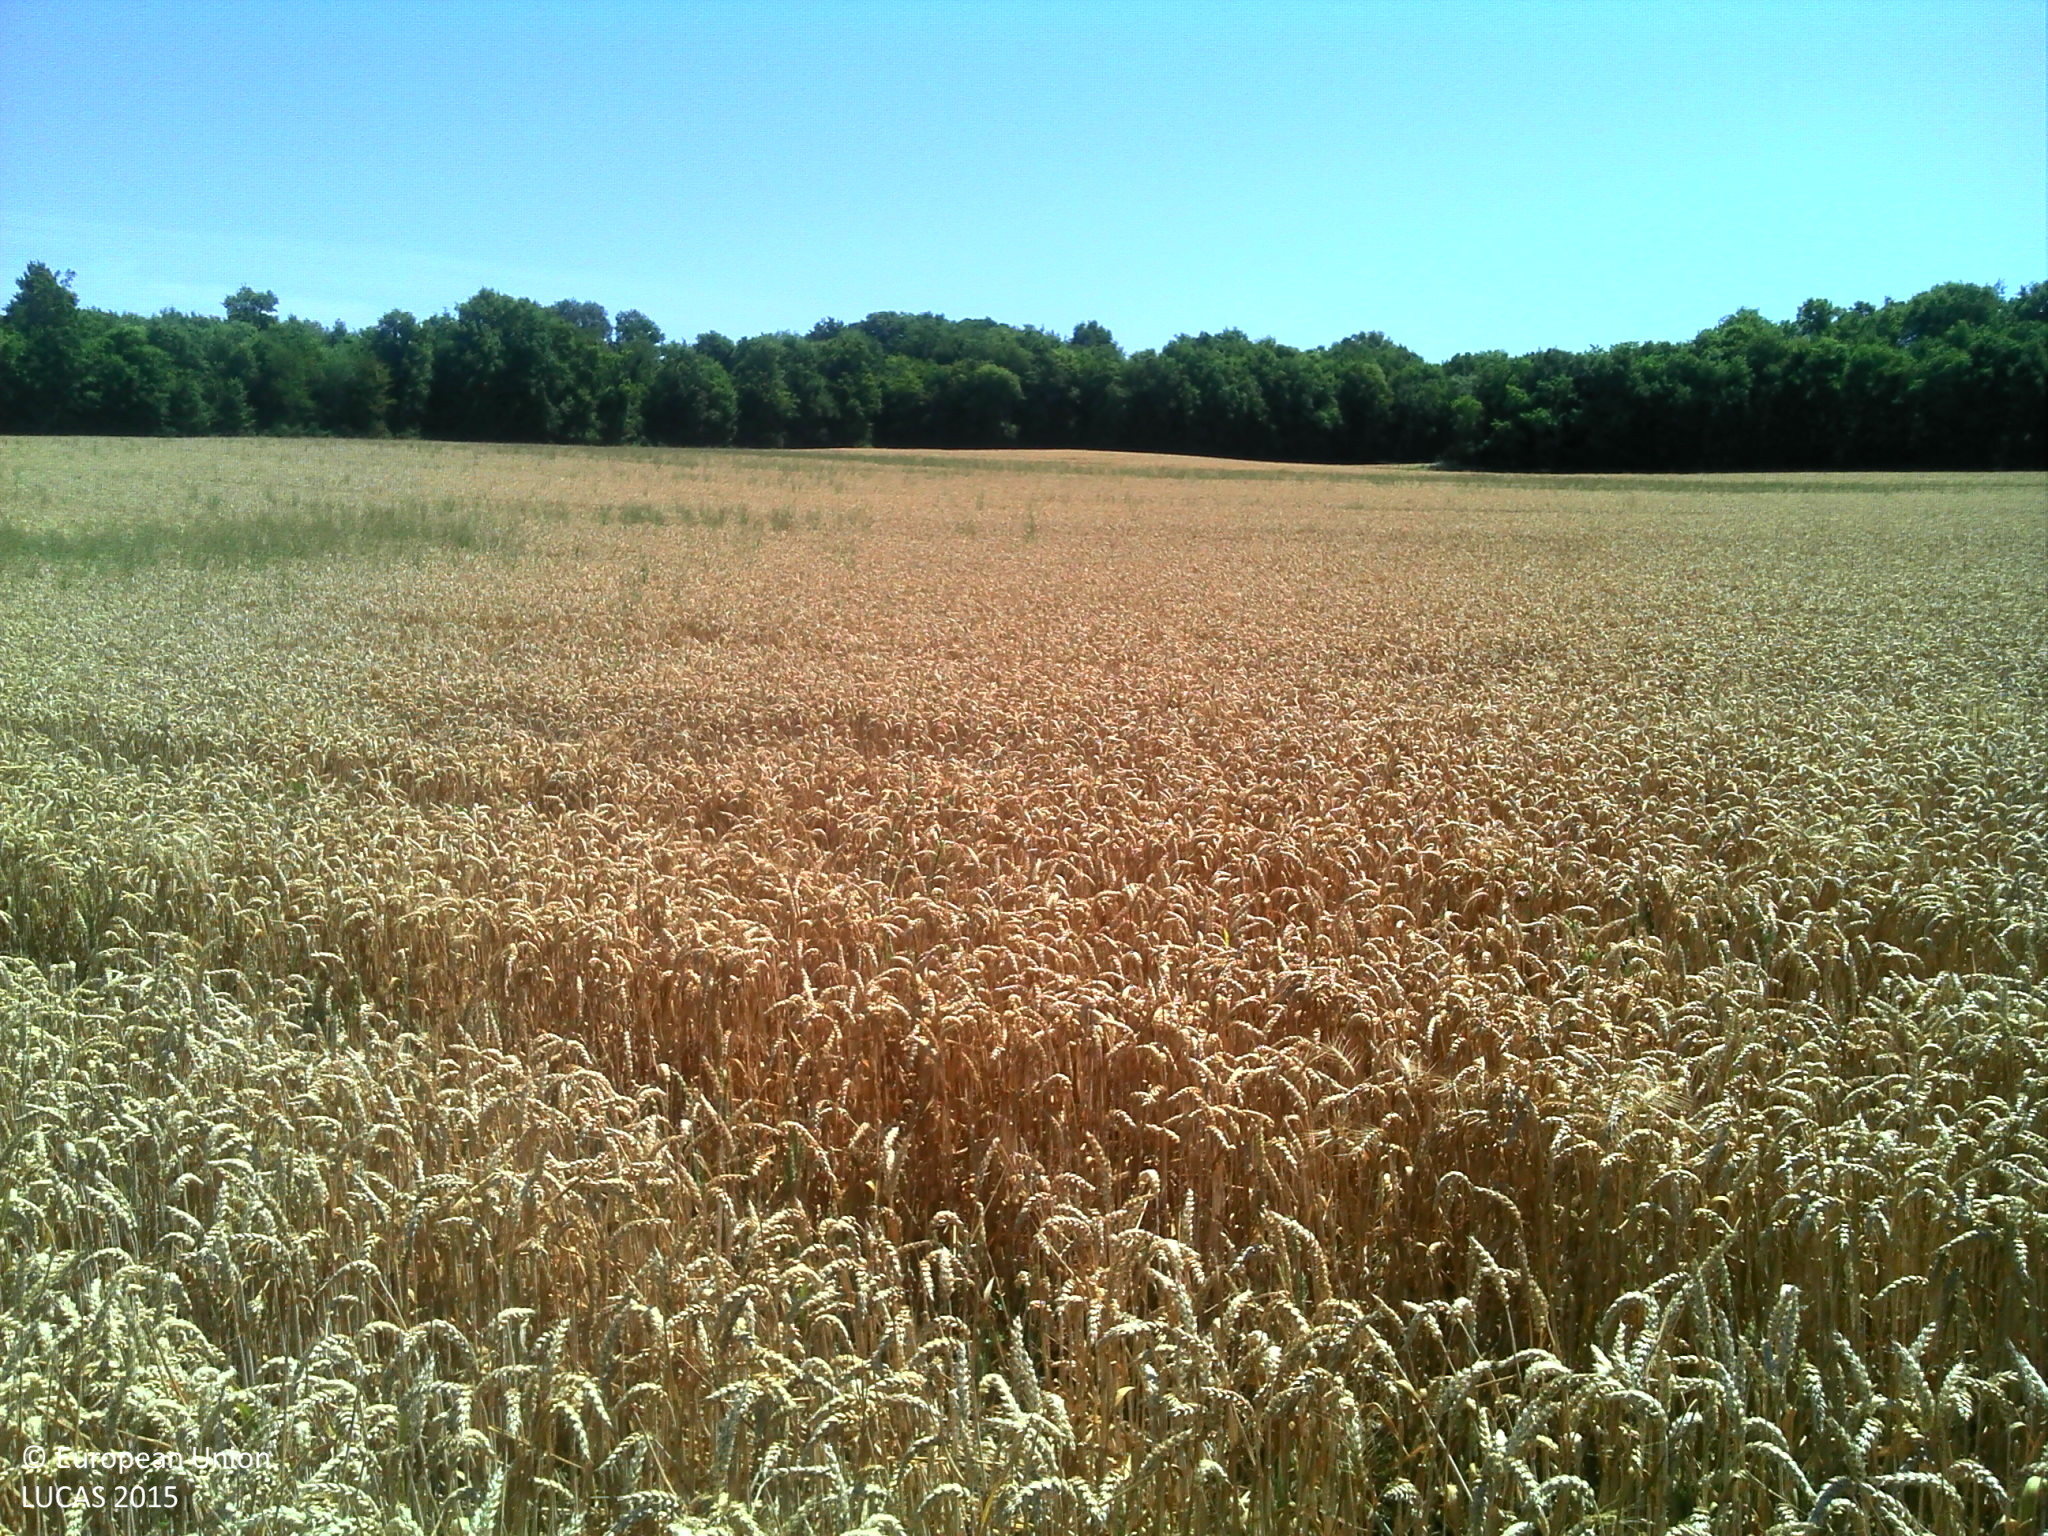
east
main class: Cropland
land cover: Common wheat
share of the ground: > 75 %
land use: Agriculture (excluding fallow land and kitchen gardens)
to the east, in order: Common wheat
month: June
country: FR
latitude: 45.6863
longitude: -0.6945
